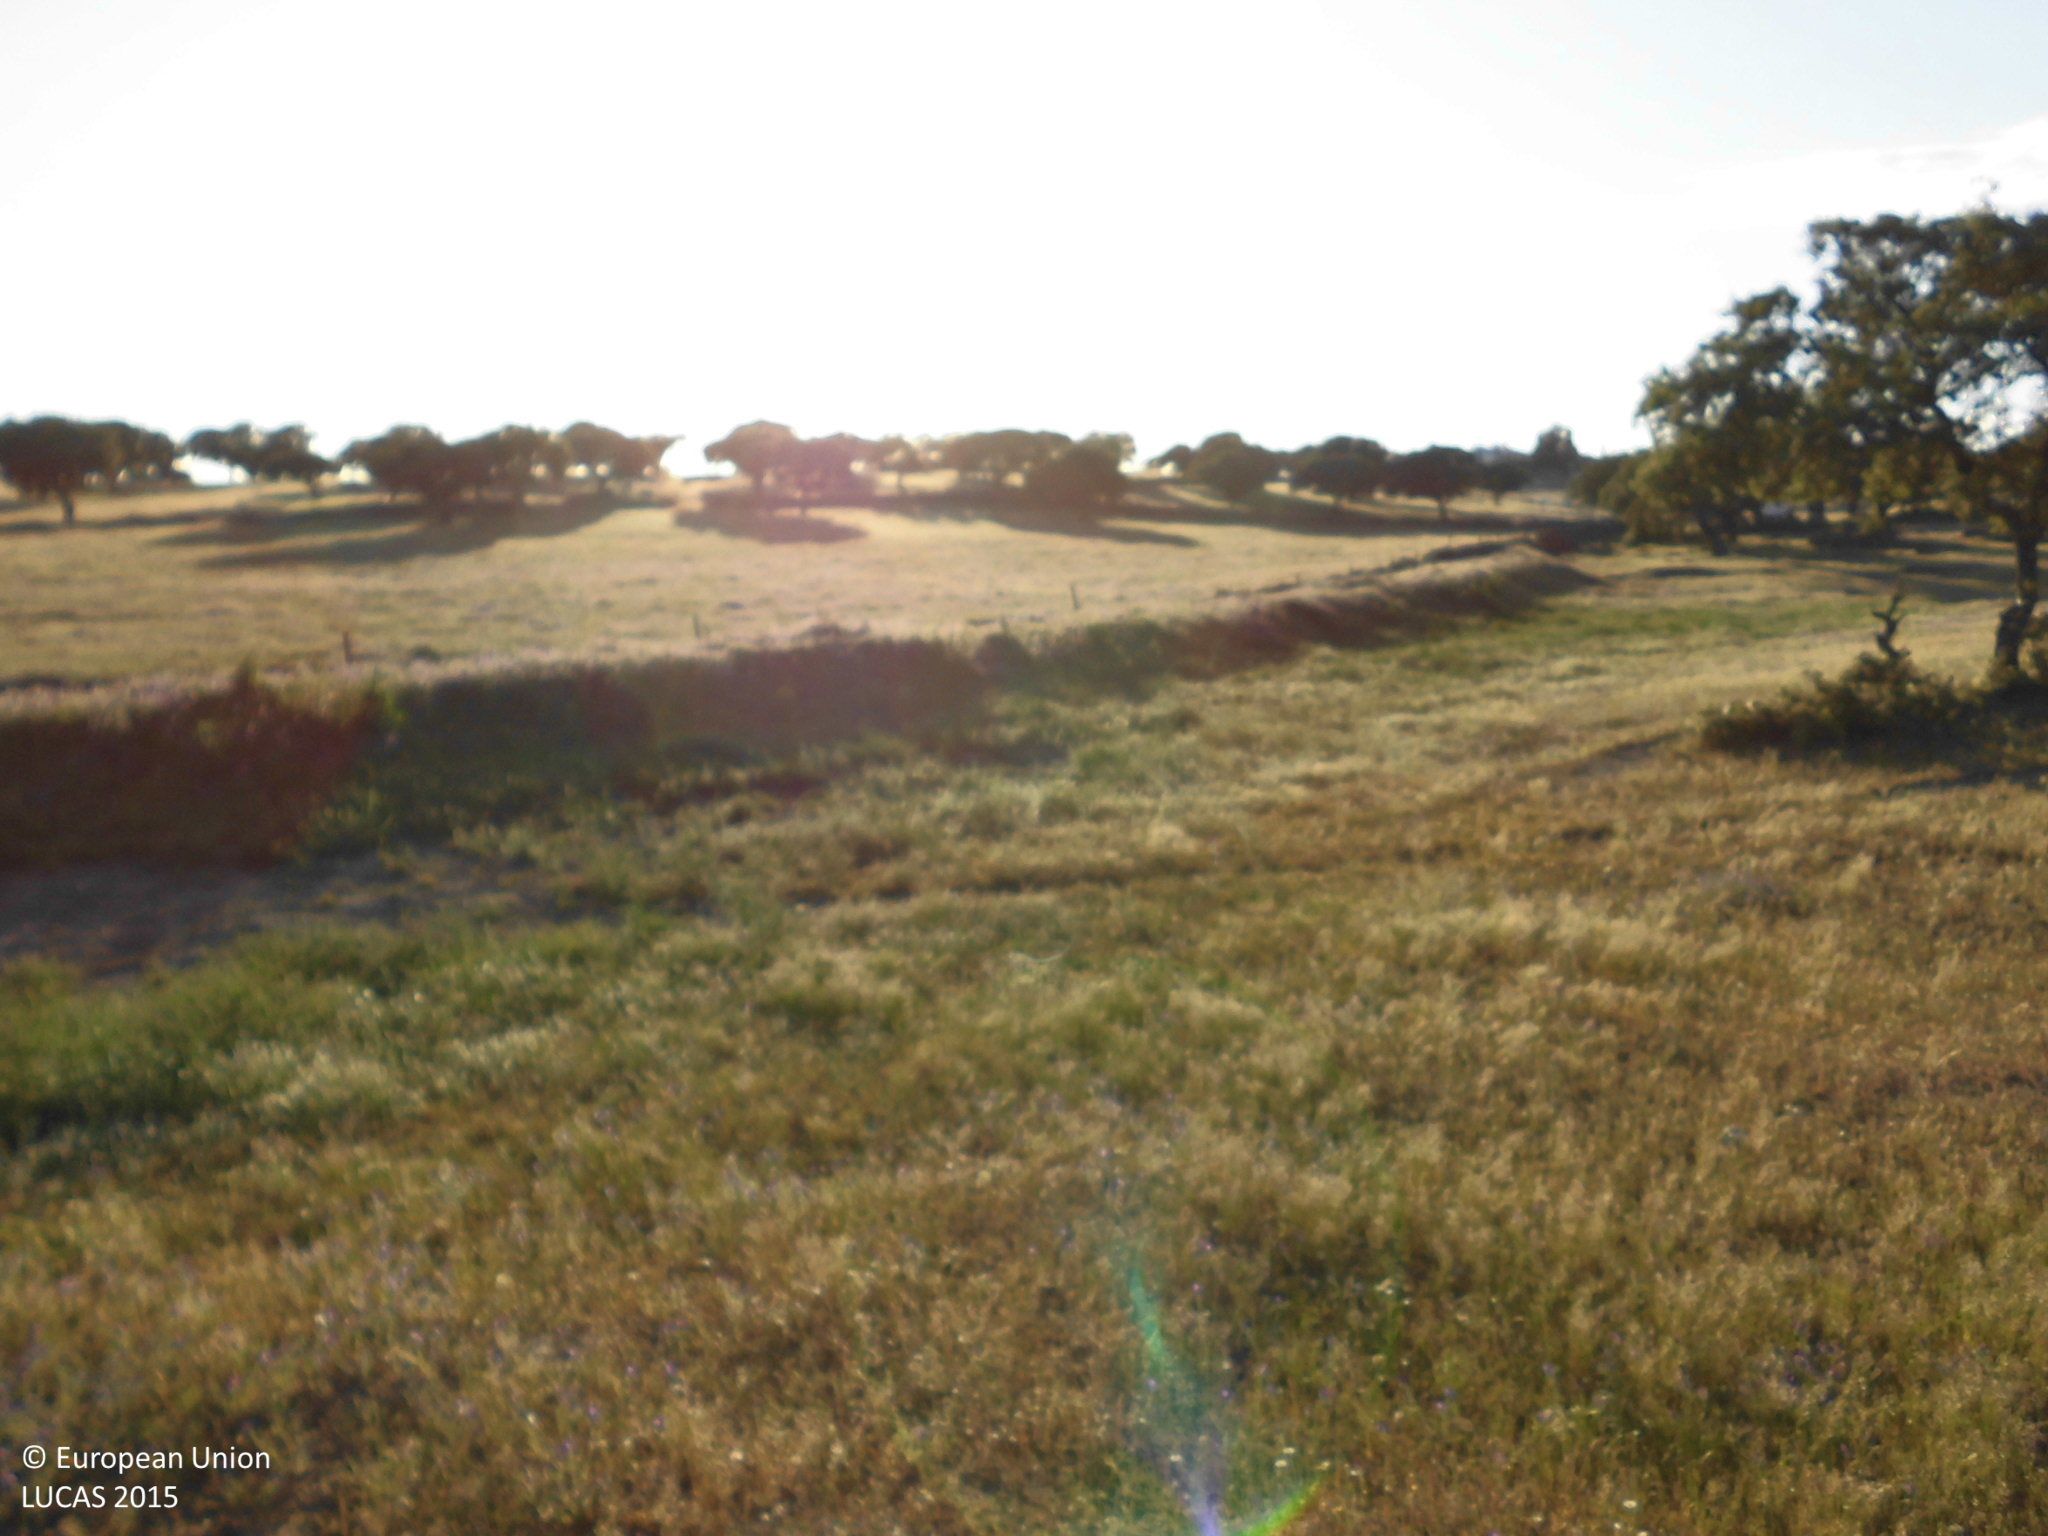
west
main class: Woodland
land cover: Broadleaved woodland
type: broadleaved evergreen forest
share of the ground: 10 - 25 %
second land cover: Grassland without tree/shrub cover
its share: > 75 %
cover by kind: herbaceous plants 85 %, broadleaved forest trees 15 %
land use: Forestry
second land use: Agriculture (excluding fallow land and kitchen gardens)
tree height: > 5 m
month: May
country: ES
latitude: 39.4671
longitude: -6.0673
